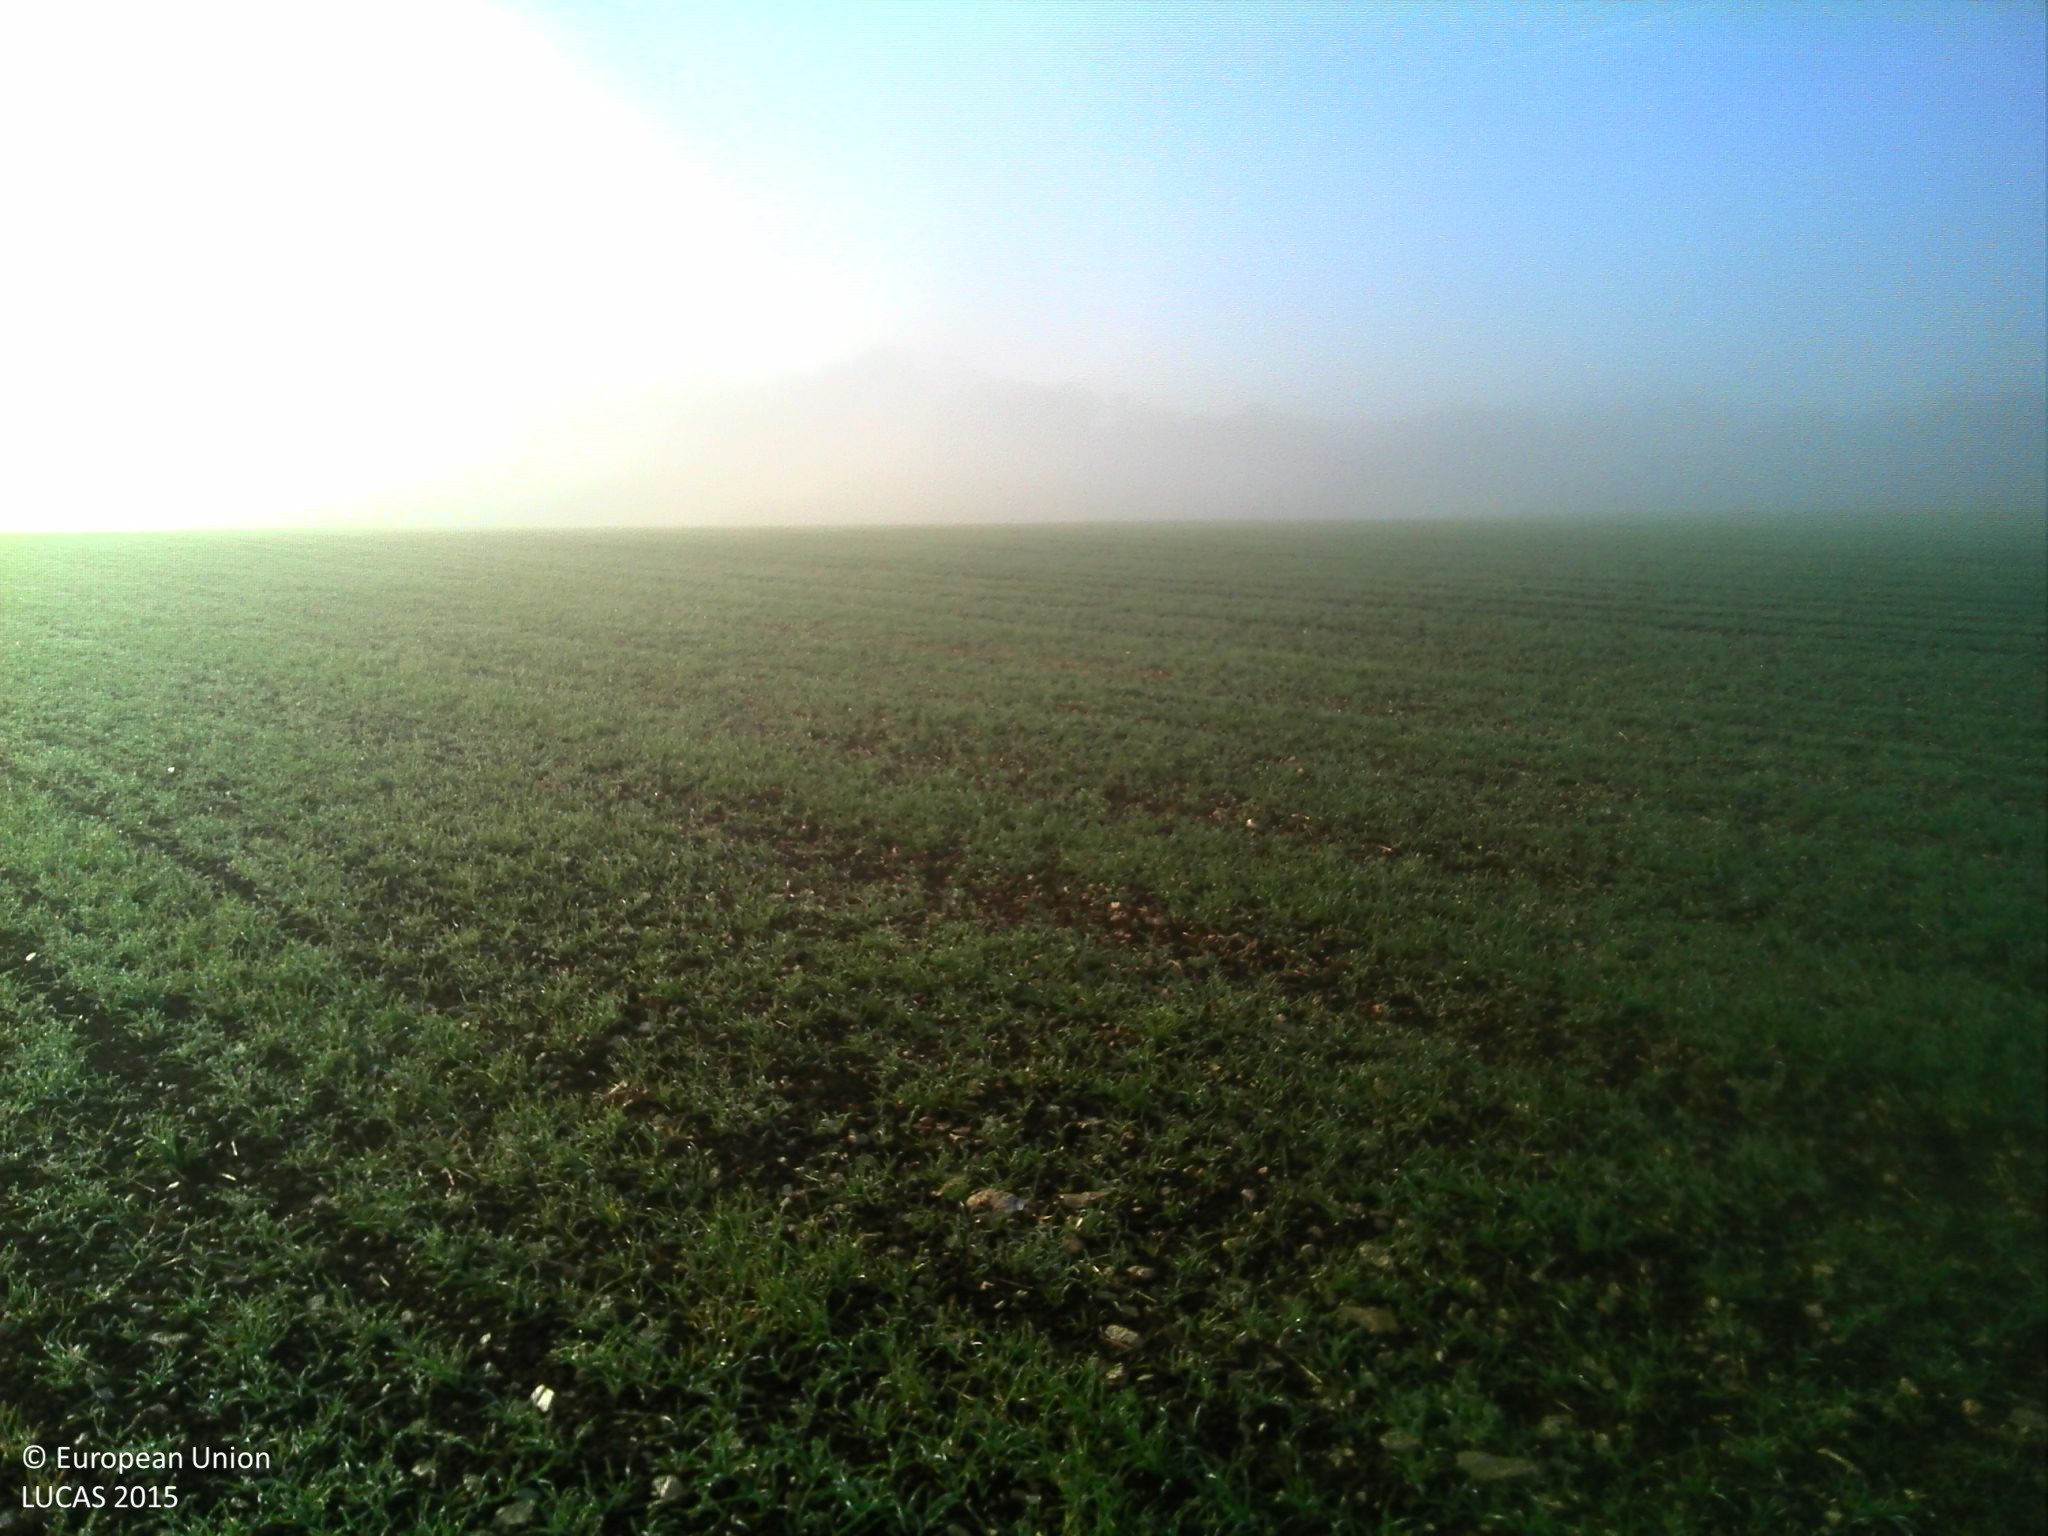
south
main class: Cropland
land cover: Common wheat
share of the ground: > 75 %
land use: Agriculture (excluding fallow land and kitchen gardens)
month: December
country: FR
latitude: 47.4889
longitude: 3.1863
